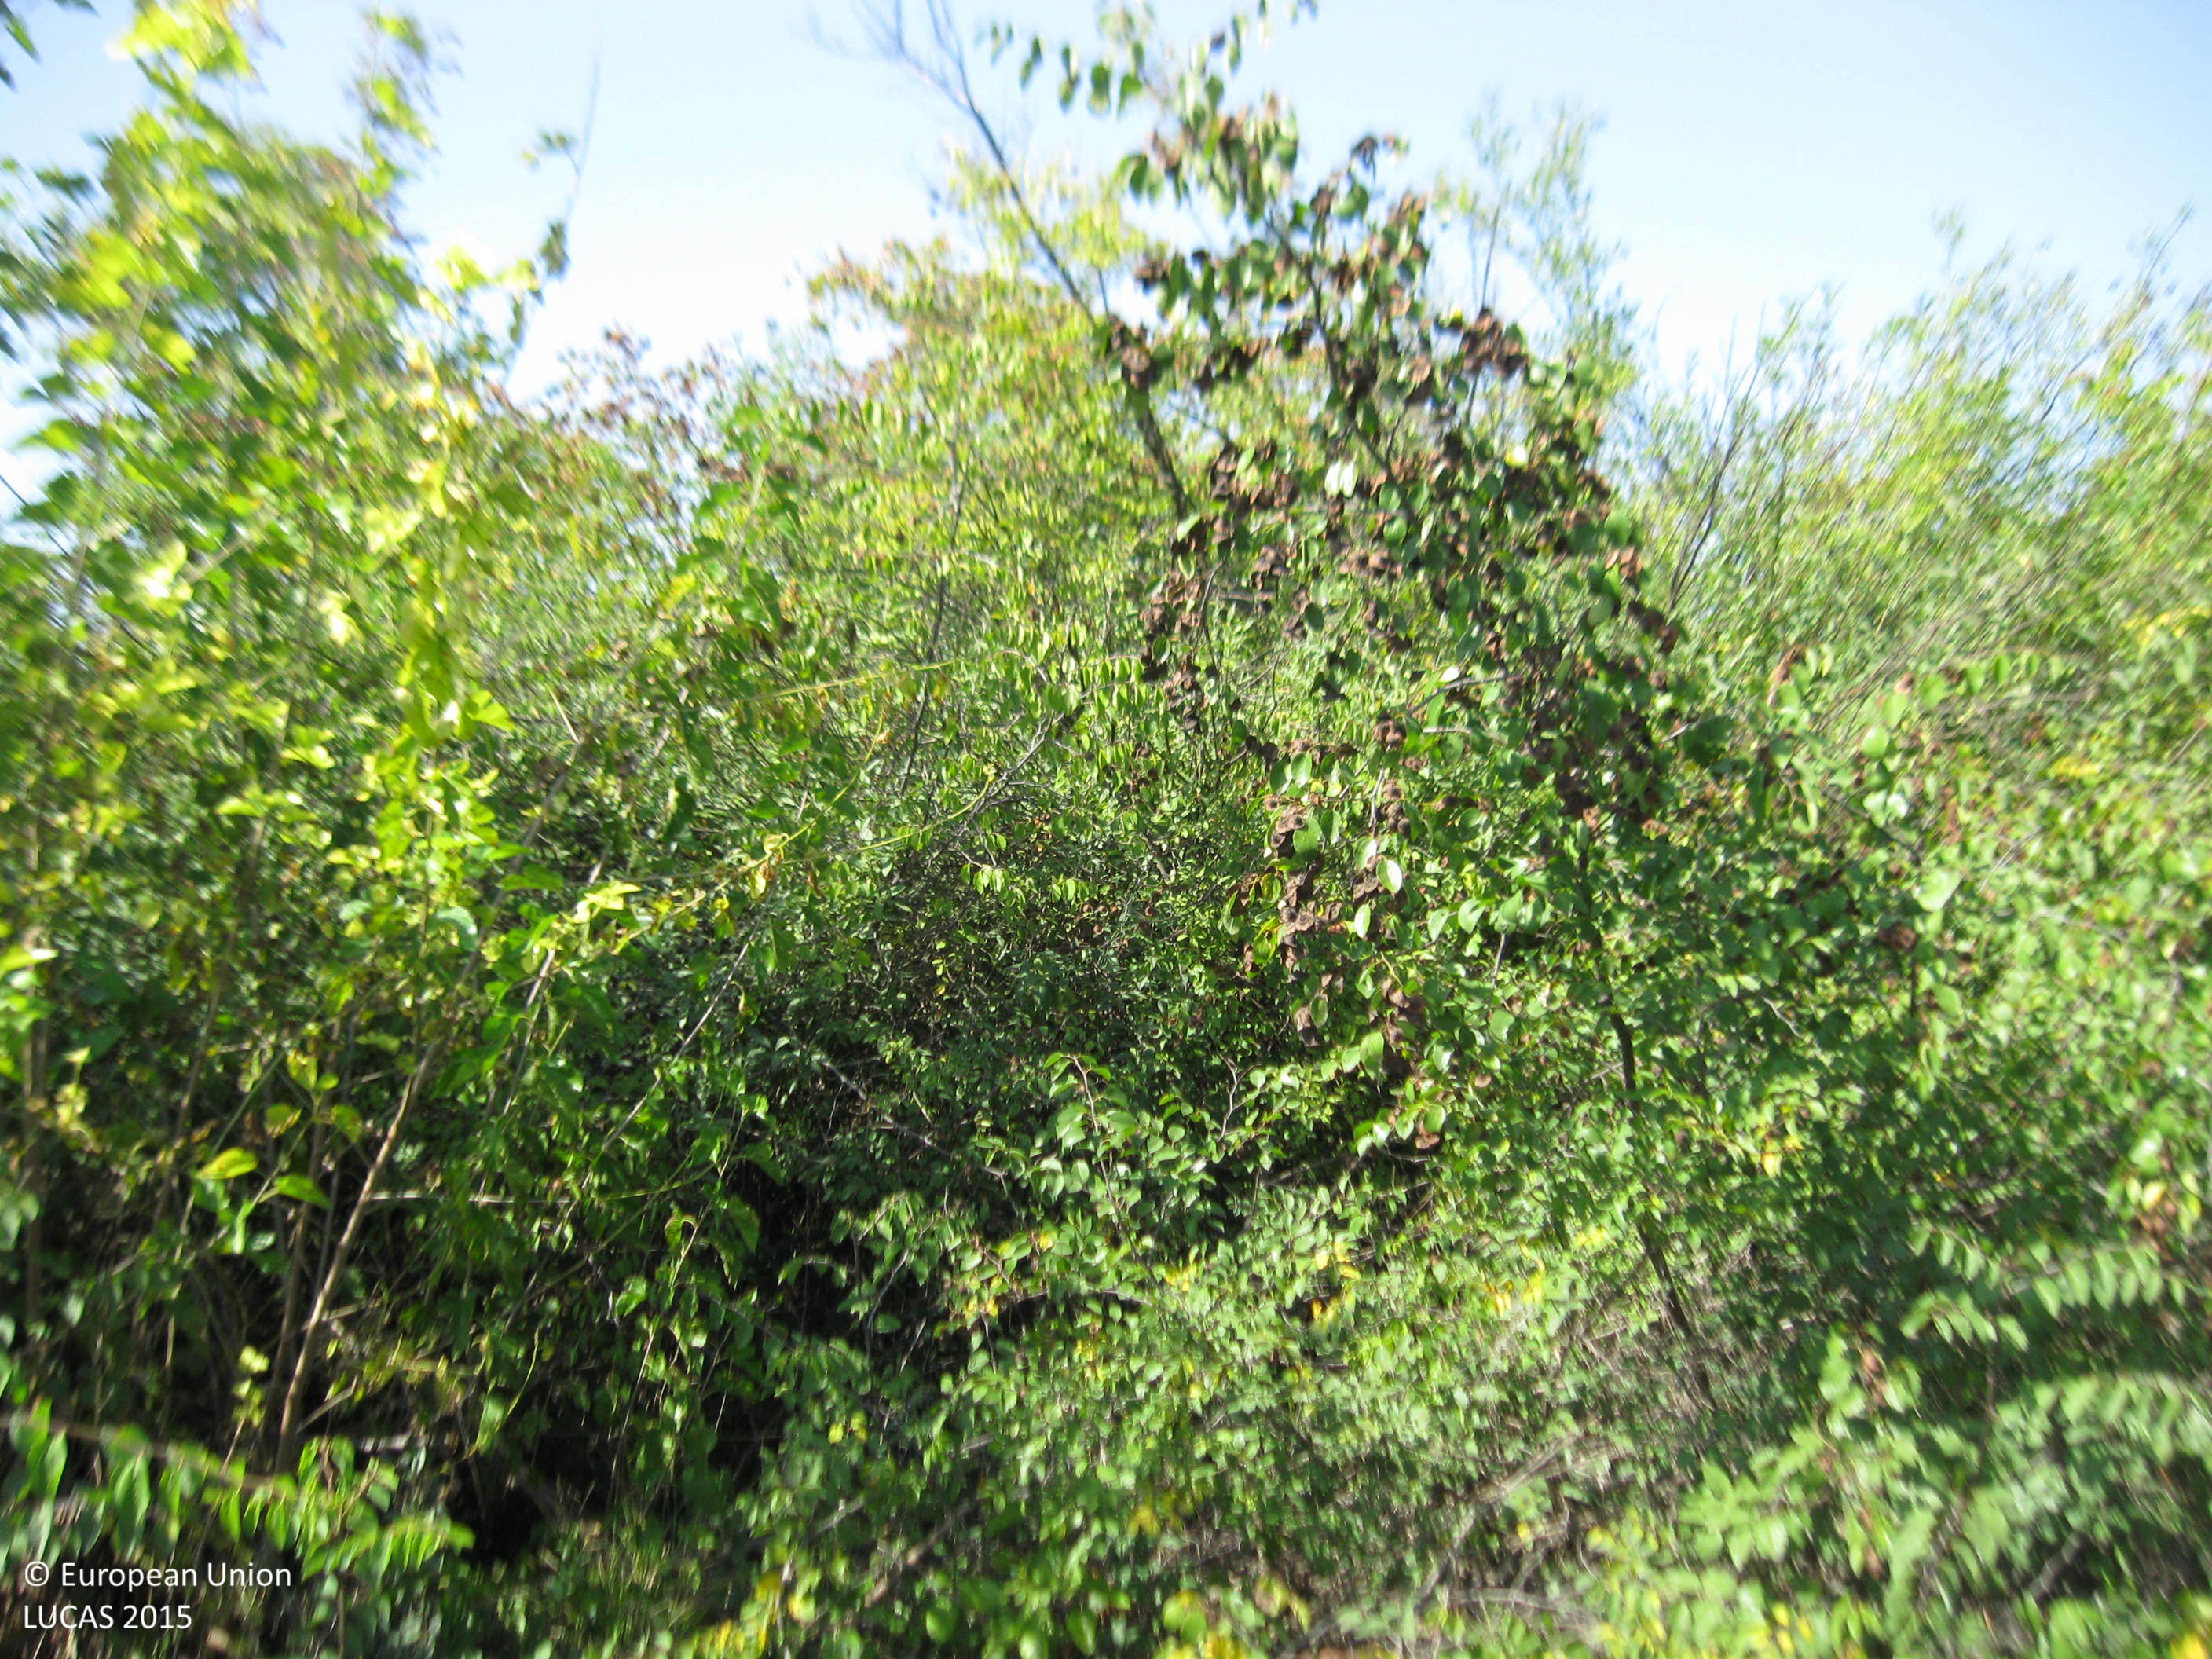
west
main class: Shrubland
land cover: Shrubland with sparse tree cover
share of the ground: > 75 %
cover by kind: herbaceous plants 60 %, shrubs 35 %, broadleaved forest trees 5 %
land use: Semi-natural and natural areas not in use
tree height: < 5 m
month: September
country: BG
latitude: 42.0749
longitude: 24.5392
